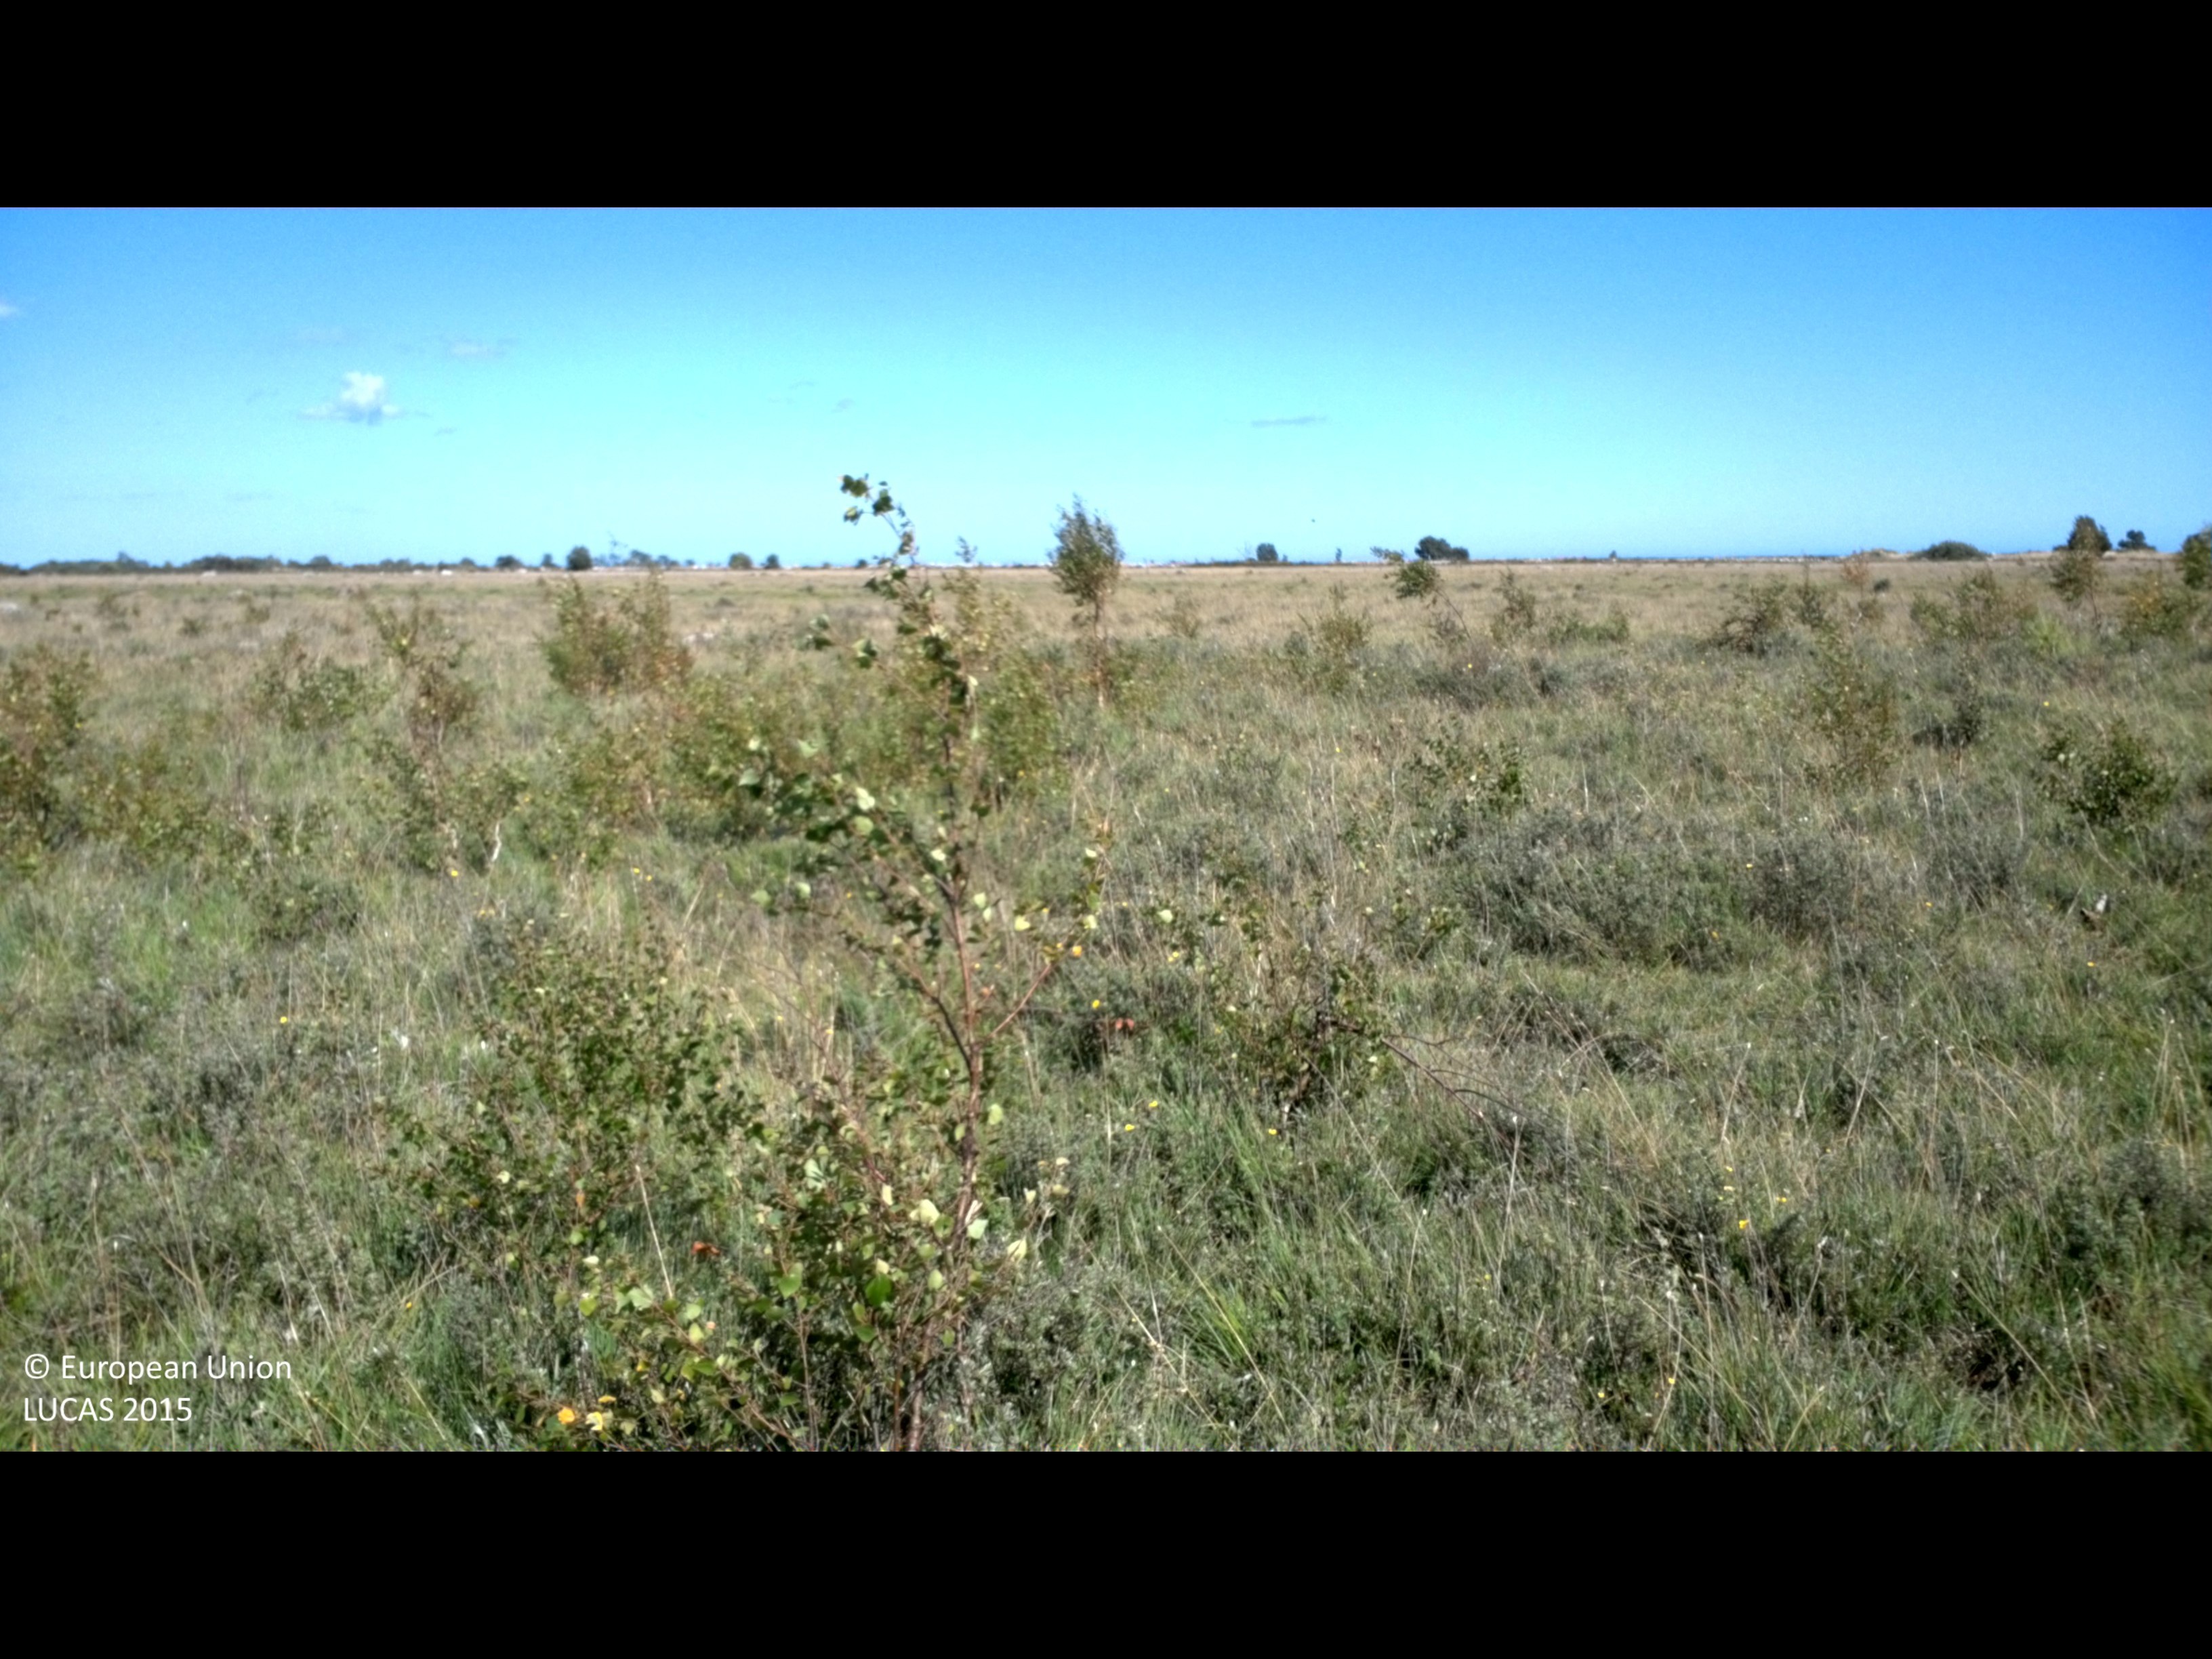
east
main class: Grassland
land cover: Grassland with sparse tree/shrub cover
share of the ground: > 75 %
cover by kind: herbaceous plants 90 %, broadleaved forest trees 5 %, shrubs 5 %
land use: Agriculture (excluding fallow land and kitchen gardens)
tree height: < 5 m
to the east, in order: Grassland with sparse tree/shrub cover; Grassland without tree/shrub cover
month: July
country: SE
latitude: 56.4344
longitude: 16.5702
